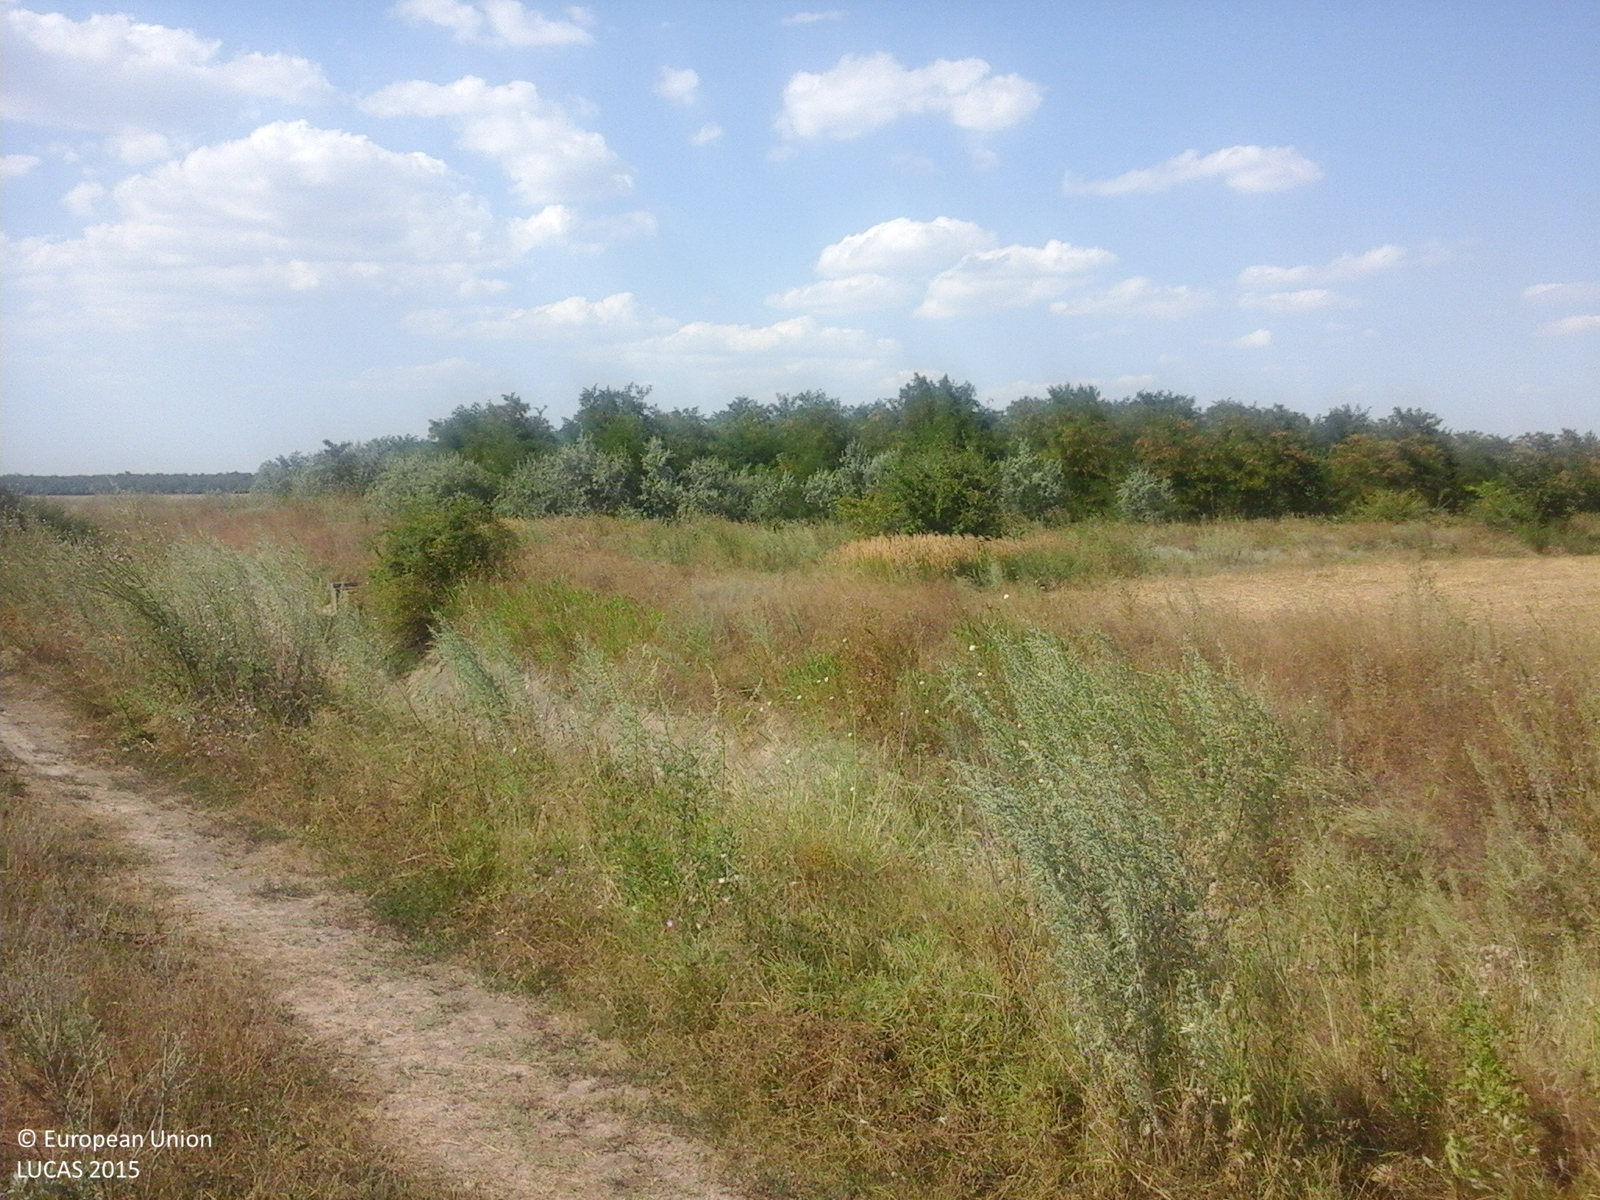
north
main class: Cropland
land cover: Barley
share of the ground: > 75 %
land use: Agriculture (excluding fallow land and kitchen gardens)
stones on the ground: < 10 %
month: August
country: RO
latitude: 44.5636
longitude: 28.1295
